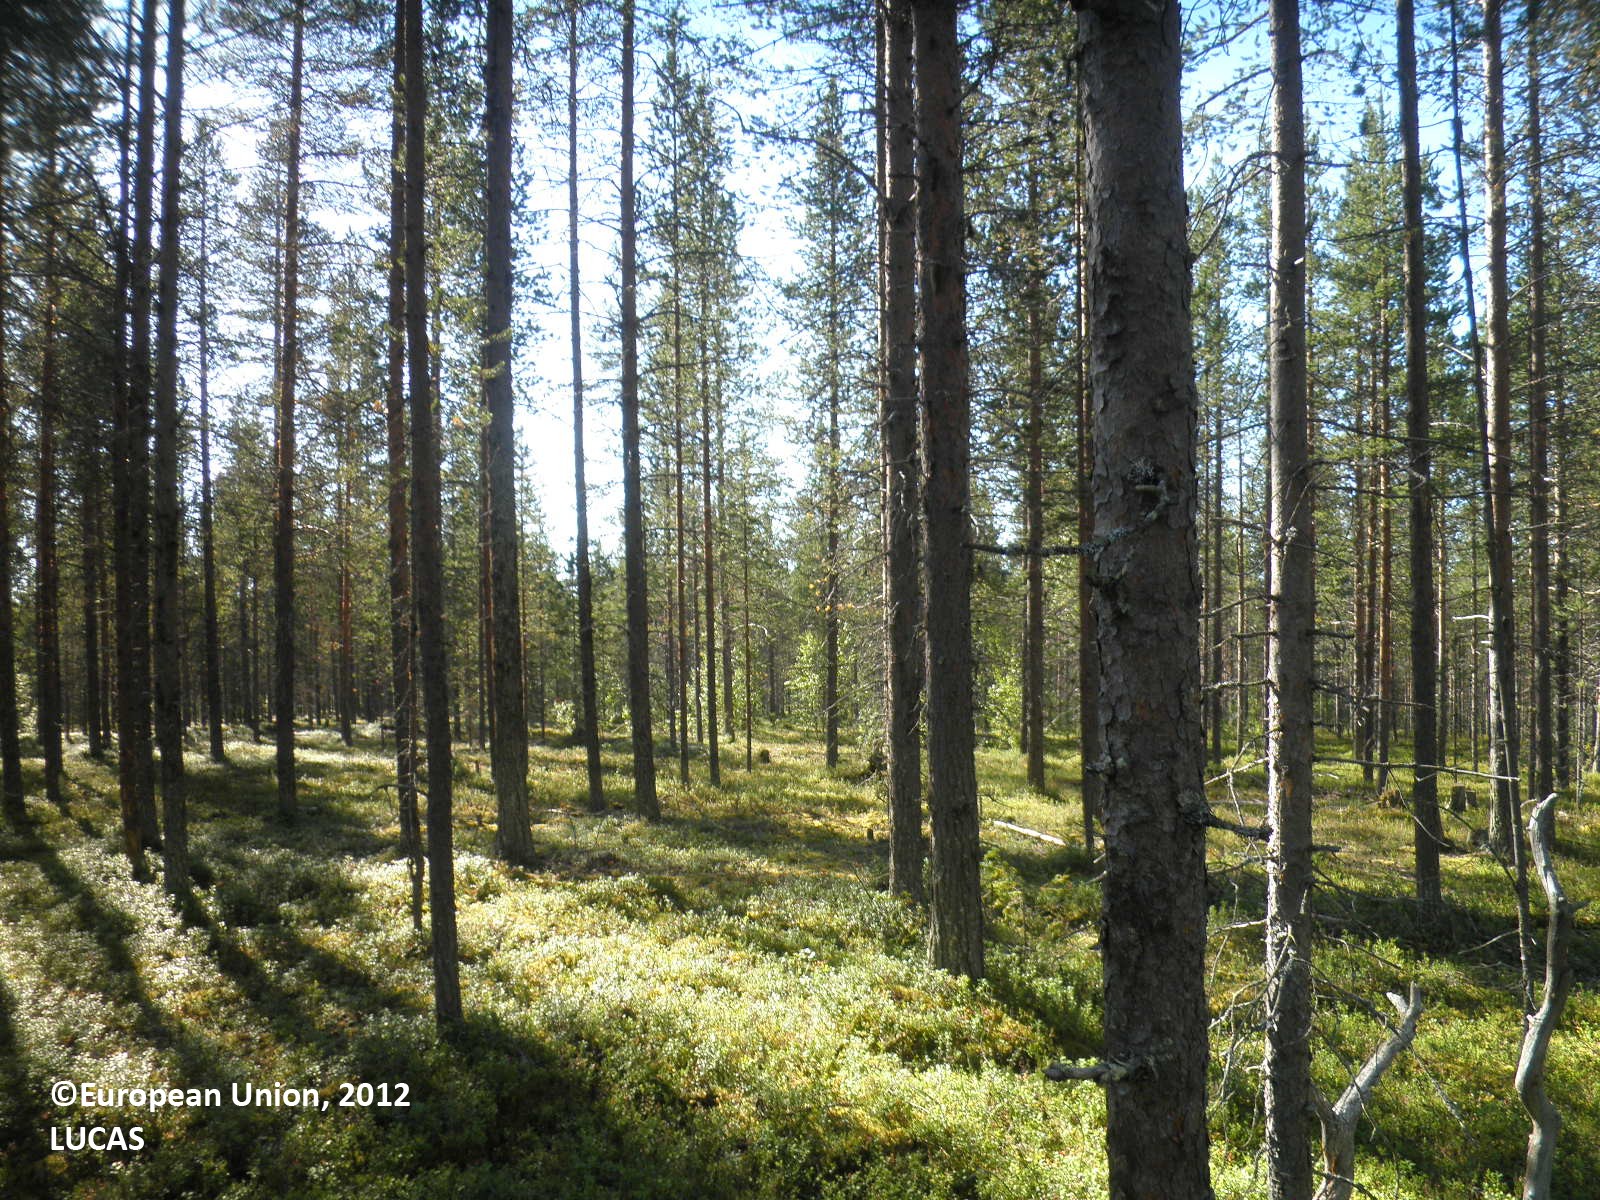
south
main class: Woodland
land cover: Pine dominated coniferous woodland
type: boreal forest
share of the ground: 50 - 75 %
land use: Forestry
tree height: > 5 m
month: August
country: FI
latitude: 67.6908
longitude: 25.4601
